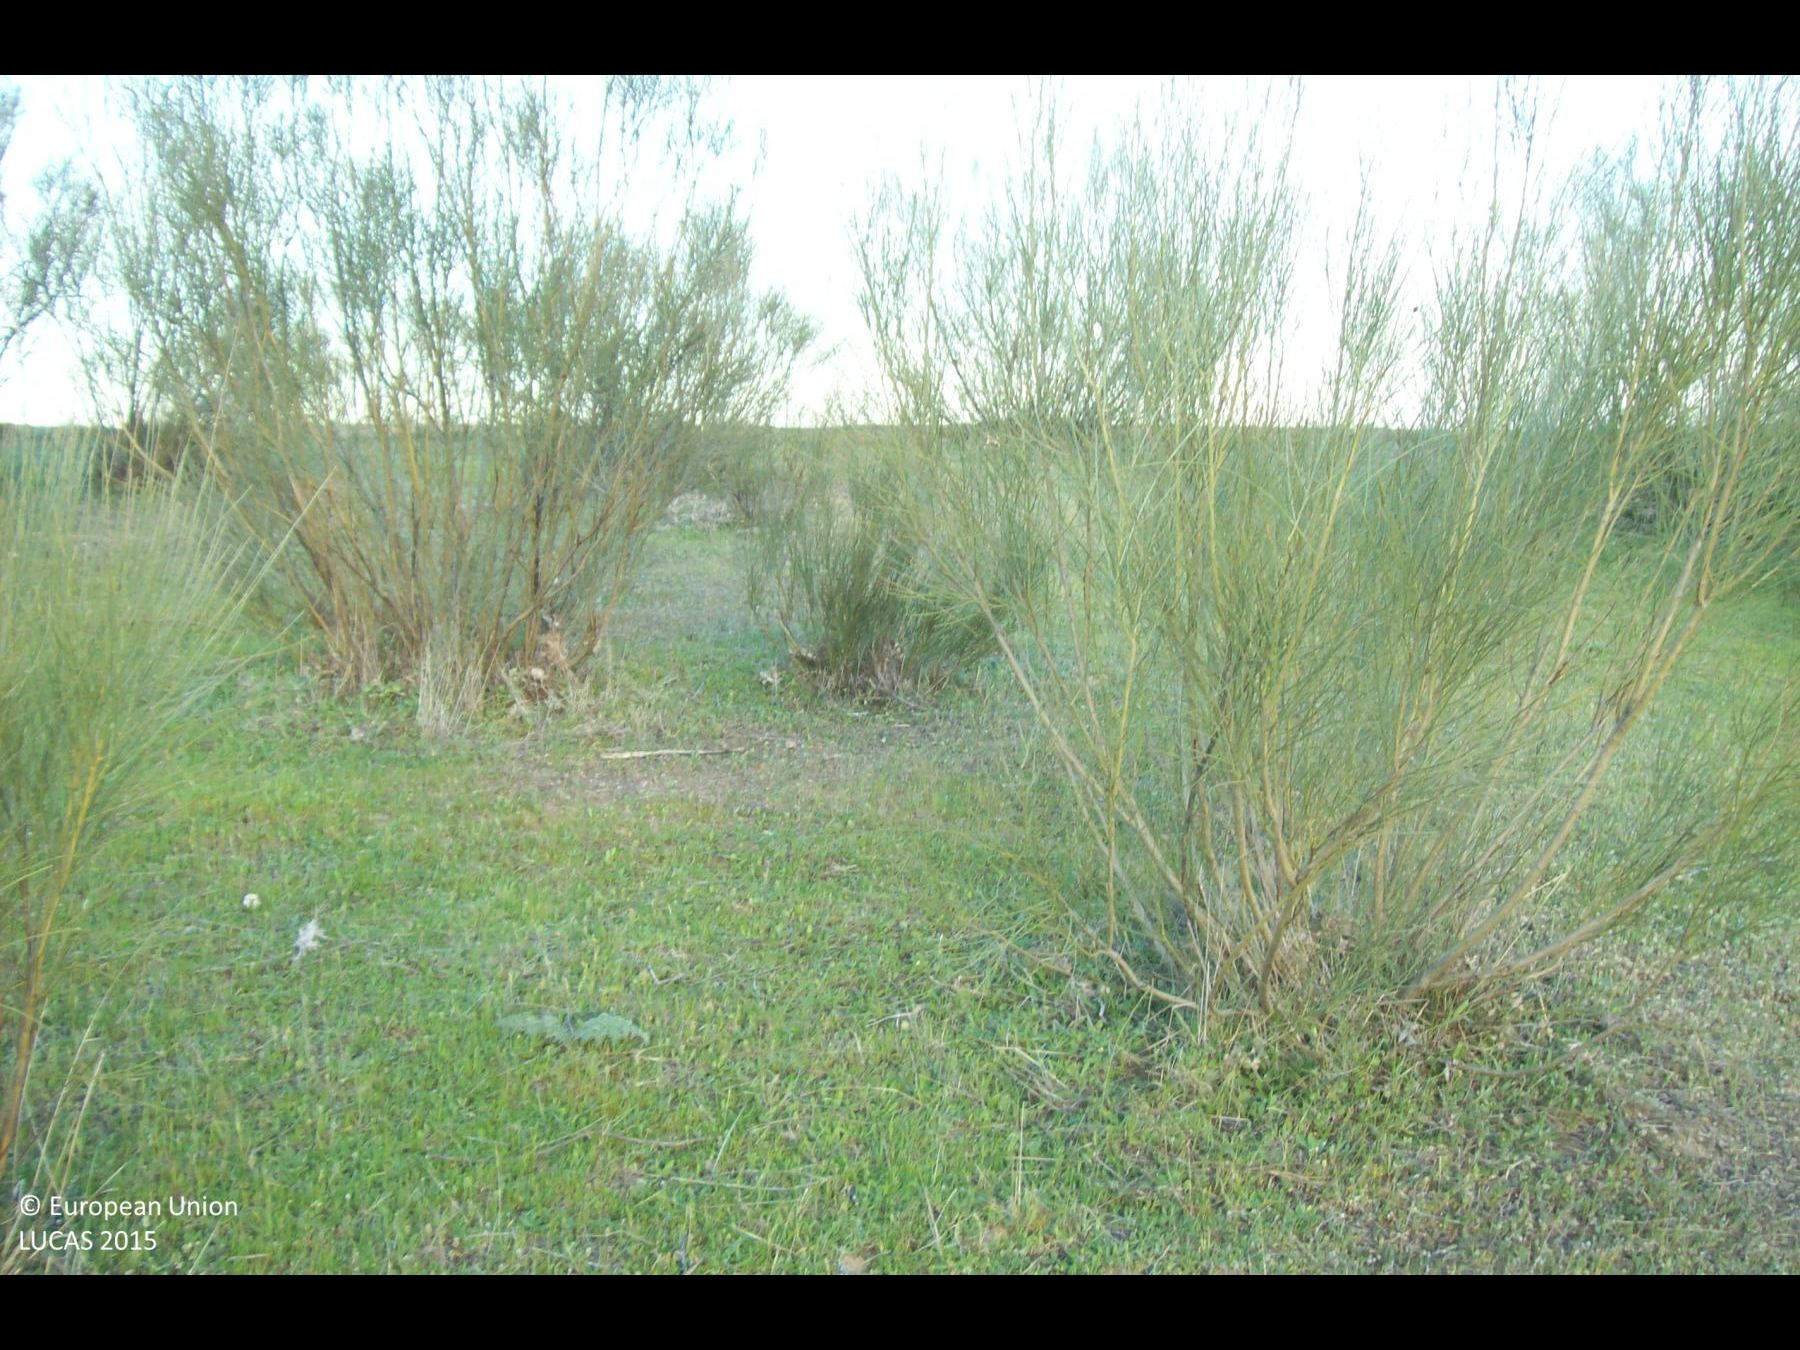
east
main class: Shrubland
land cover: Shrubland without tree cover
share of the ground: 10 - 25 %
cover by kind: herbaceous plants 90 %, shrubs 10 %
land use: Semi-natural and natural areas not in use
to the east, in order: Shrubland without tree cover; Grassland without tree/shrub cover; Shrubland without tree cover; Shrubland with sparse tree cover
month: April
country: ES
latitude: 40.3896
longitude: -3.9056
